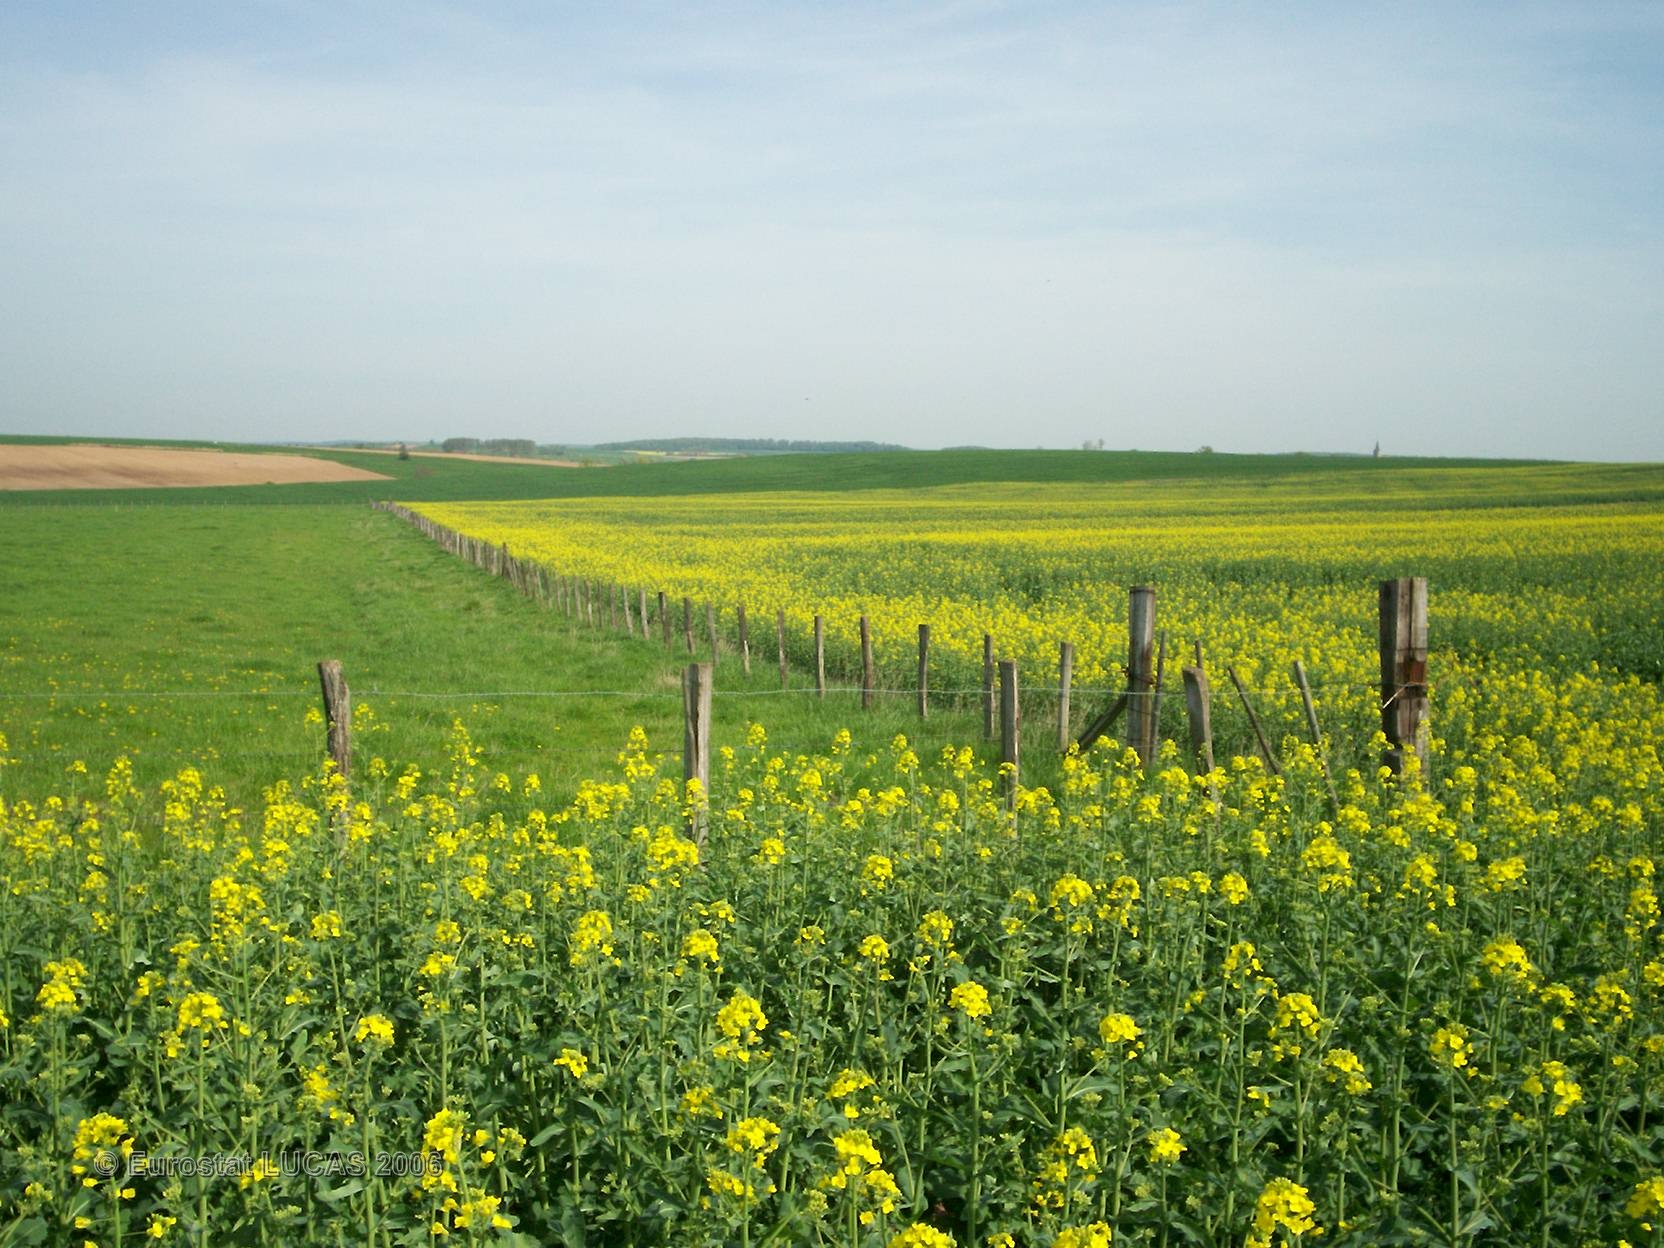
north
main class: Cropland
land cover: Rape and turnip rape
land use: Agriculture (excluding fallow land and kitchen gardens)
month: May
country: FR
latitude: 48.9550
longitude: 6.9277
